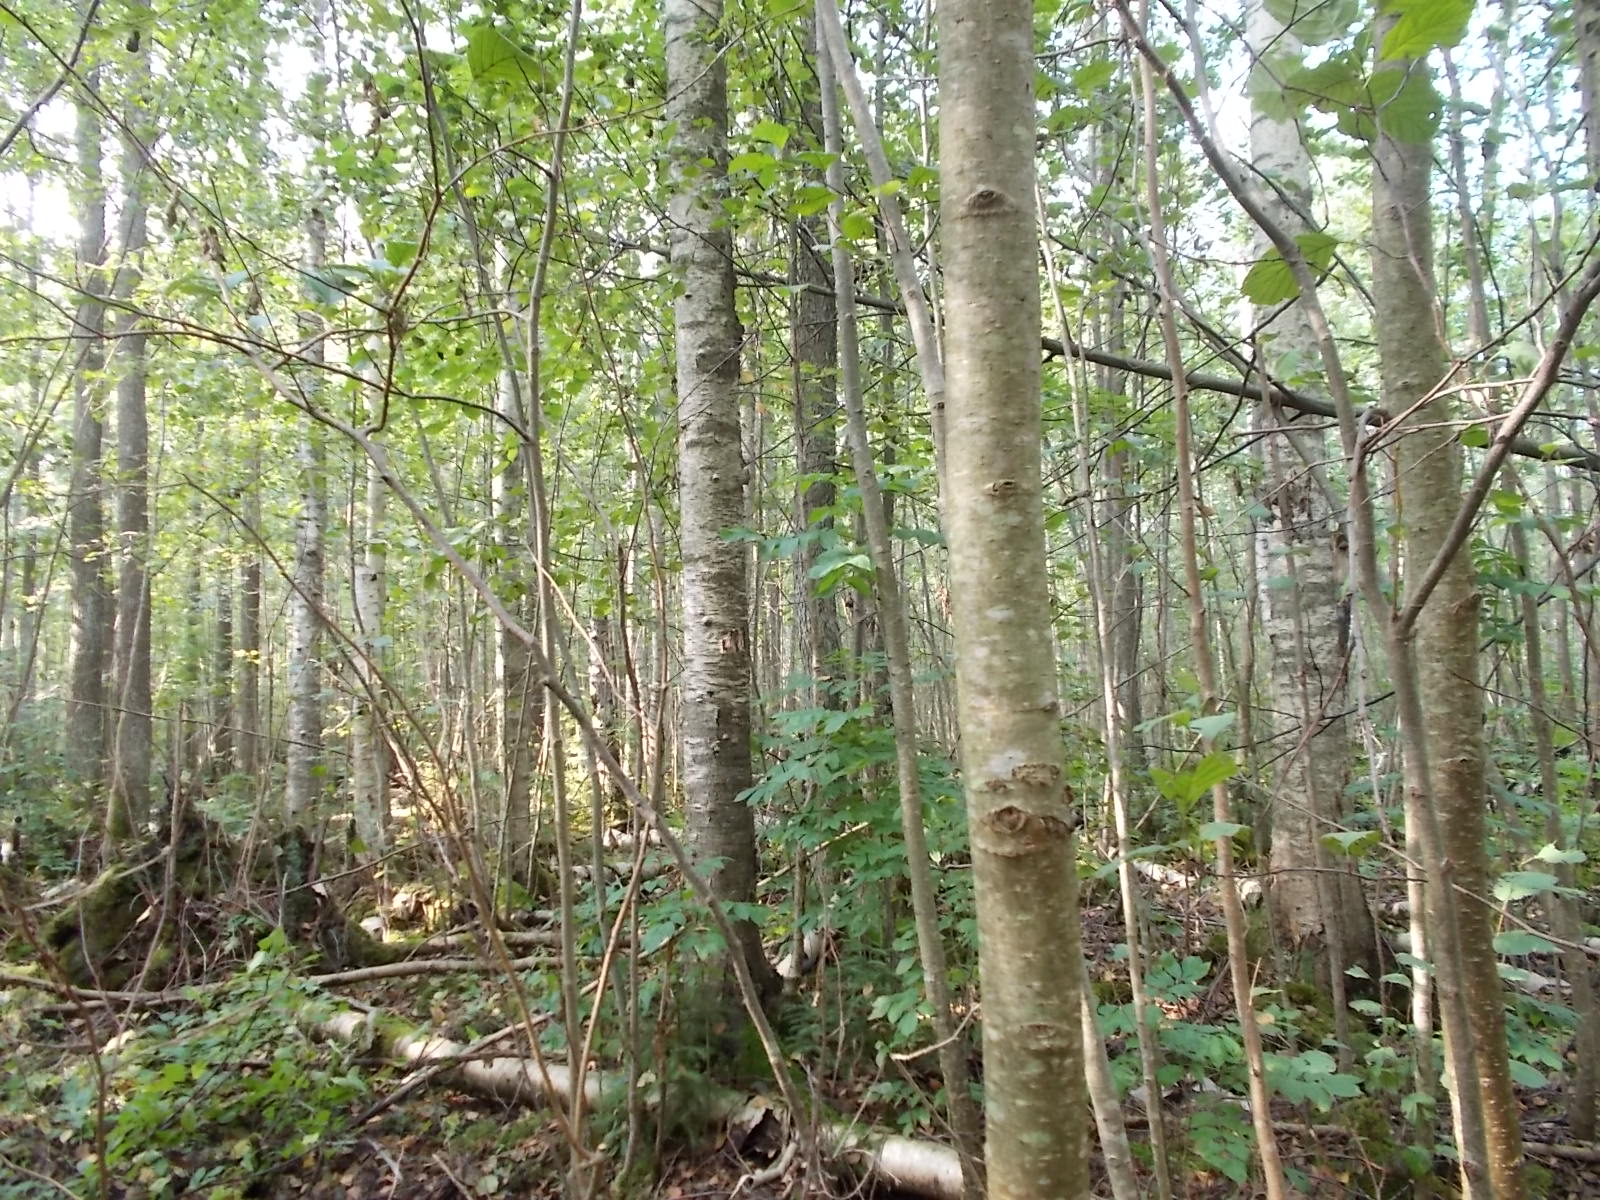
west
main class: Woodland
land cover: Broadleaved woodland
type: mire and swamp forests
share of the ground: > 75 %
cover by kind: broadleaved forest trees 90 %, herbaceous plants 10 %
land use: Forestry
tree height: > 5 m
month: September
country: LV
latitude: 56.9245
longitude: 23.5629
